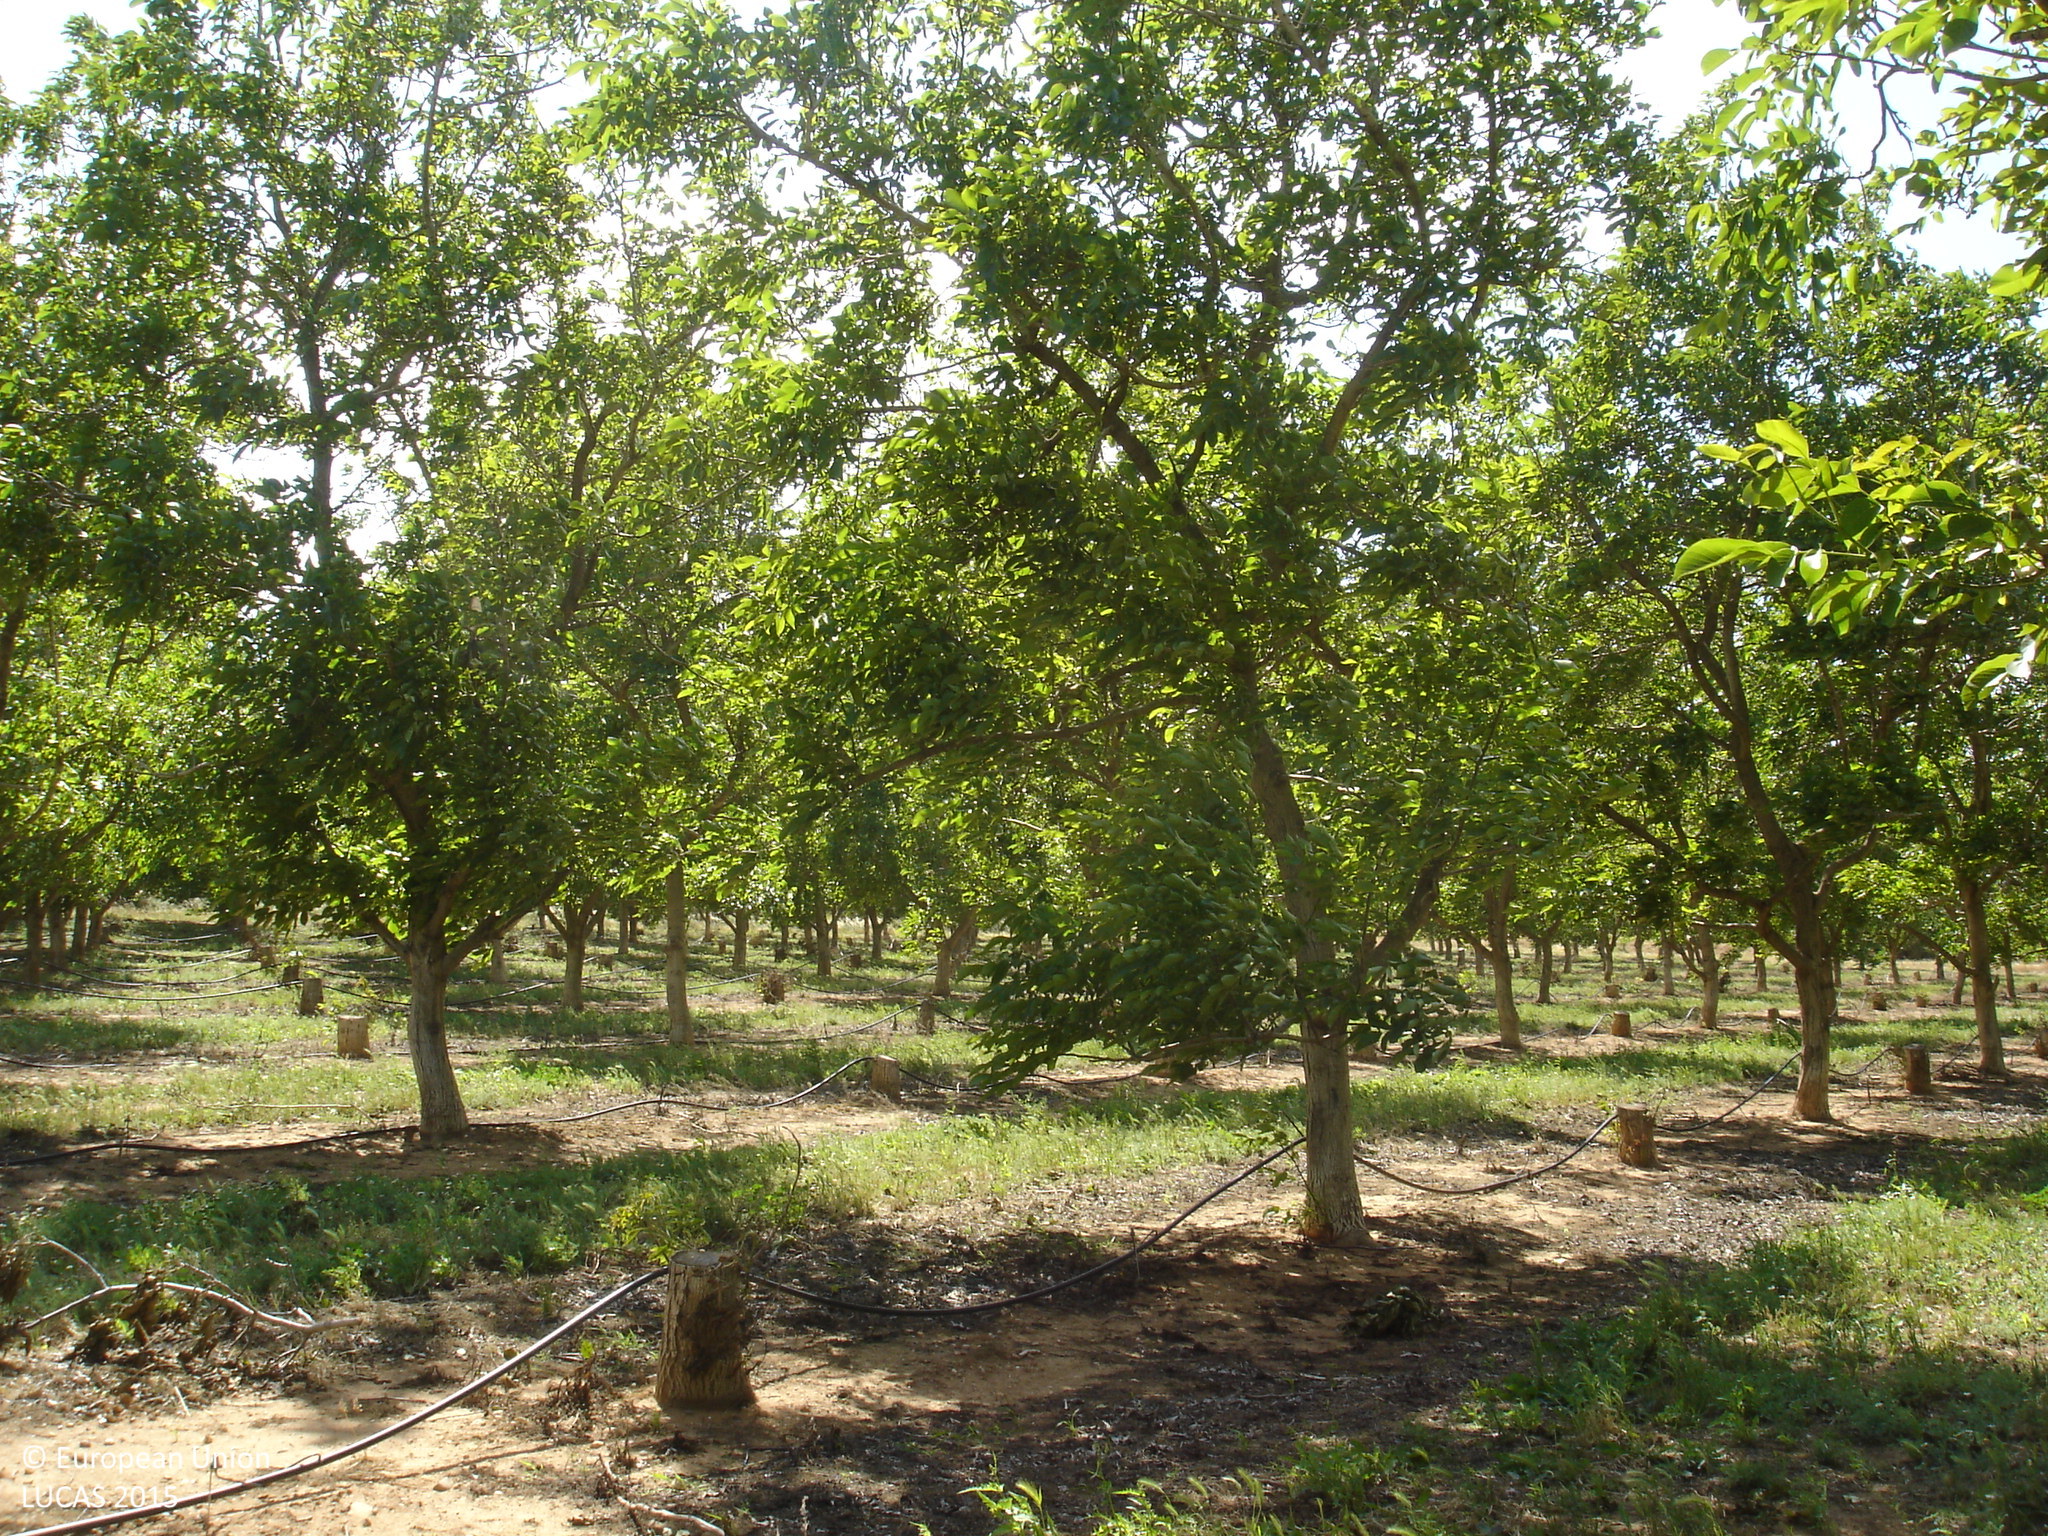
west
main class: Cropland
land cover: Nuts trees
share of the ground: > 75 %
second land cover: Spontaneously vegetated surfaces
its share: 25 - 50 %
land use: Agriculture (excluding fallow land and kitchen gardens)
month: May
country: ES
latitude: 42.1438
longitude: 3.0574
